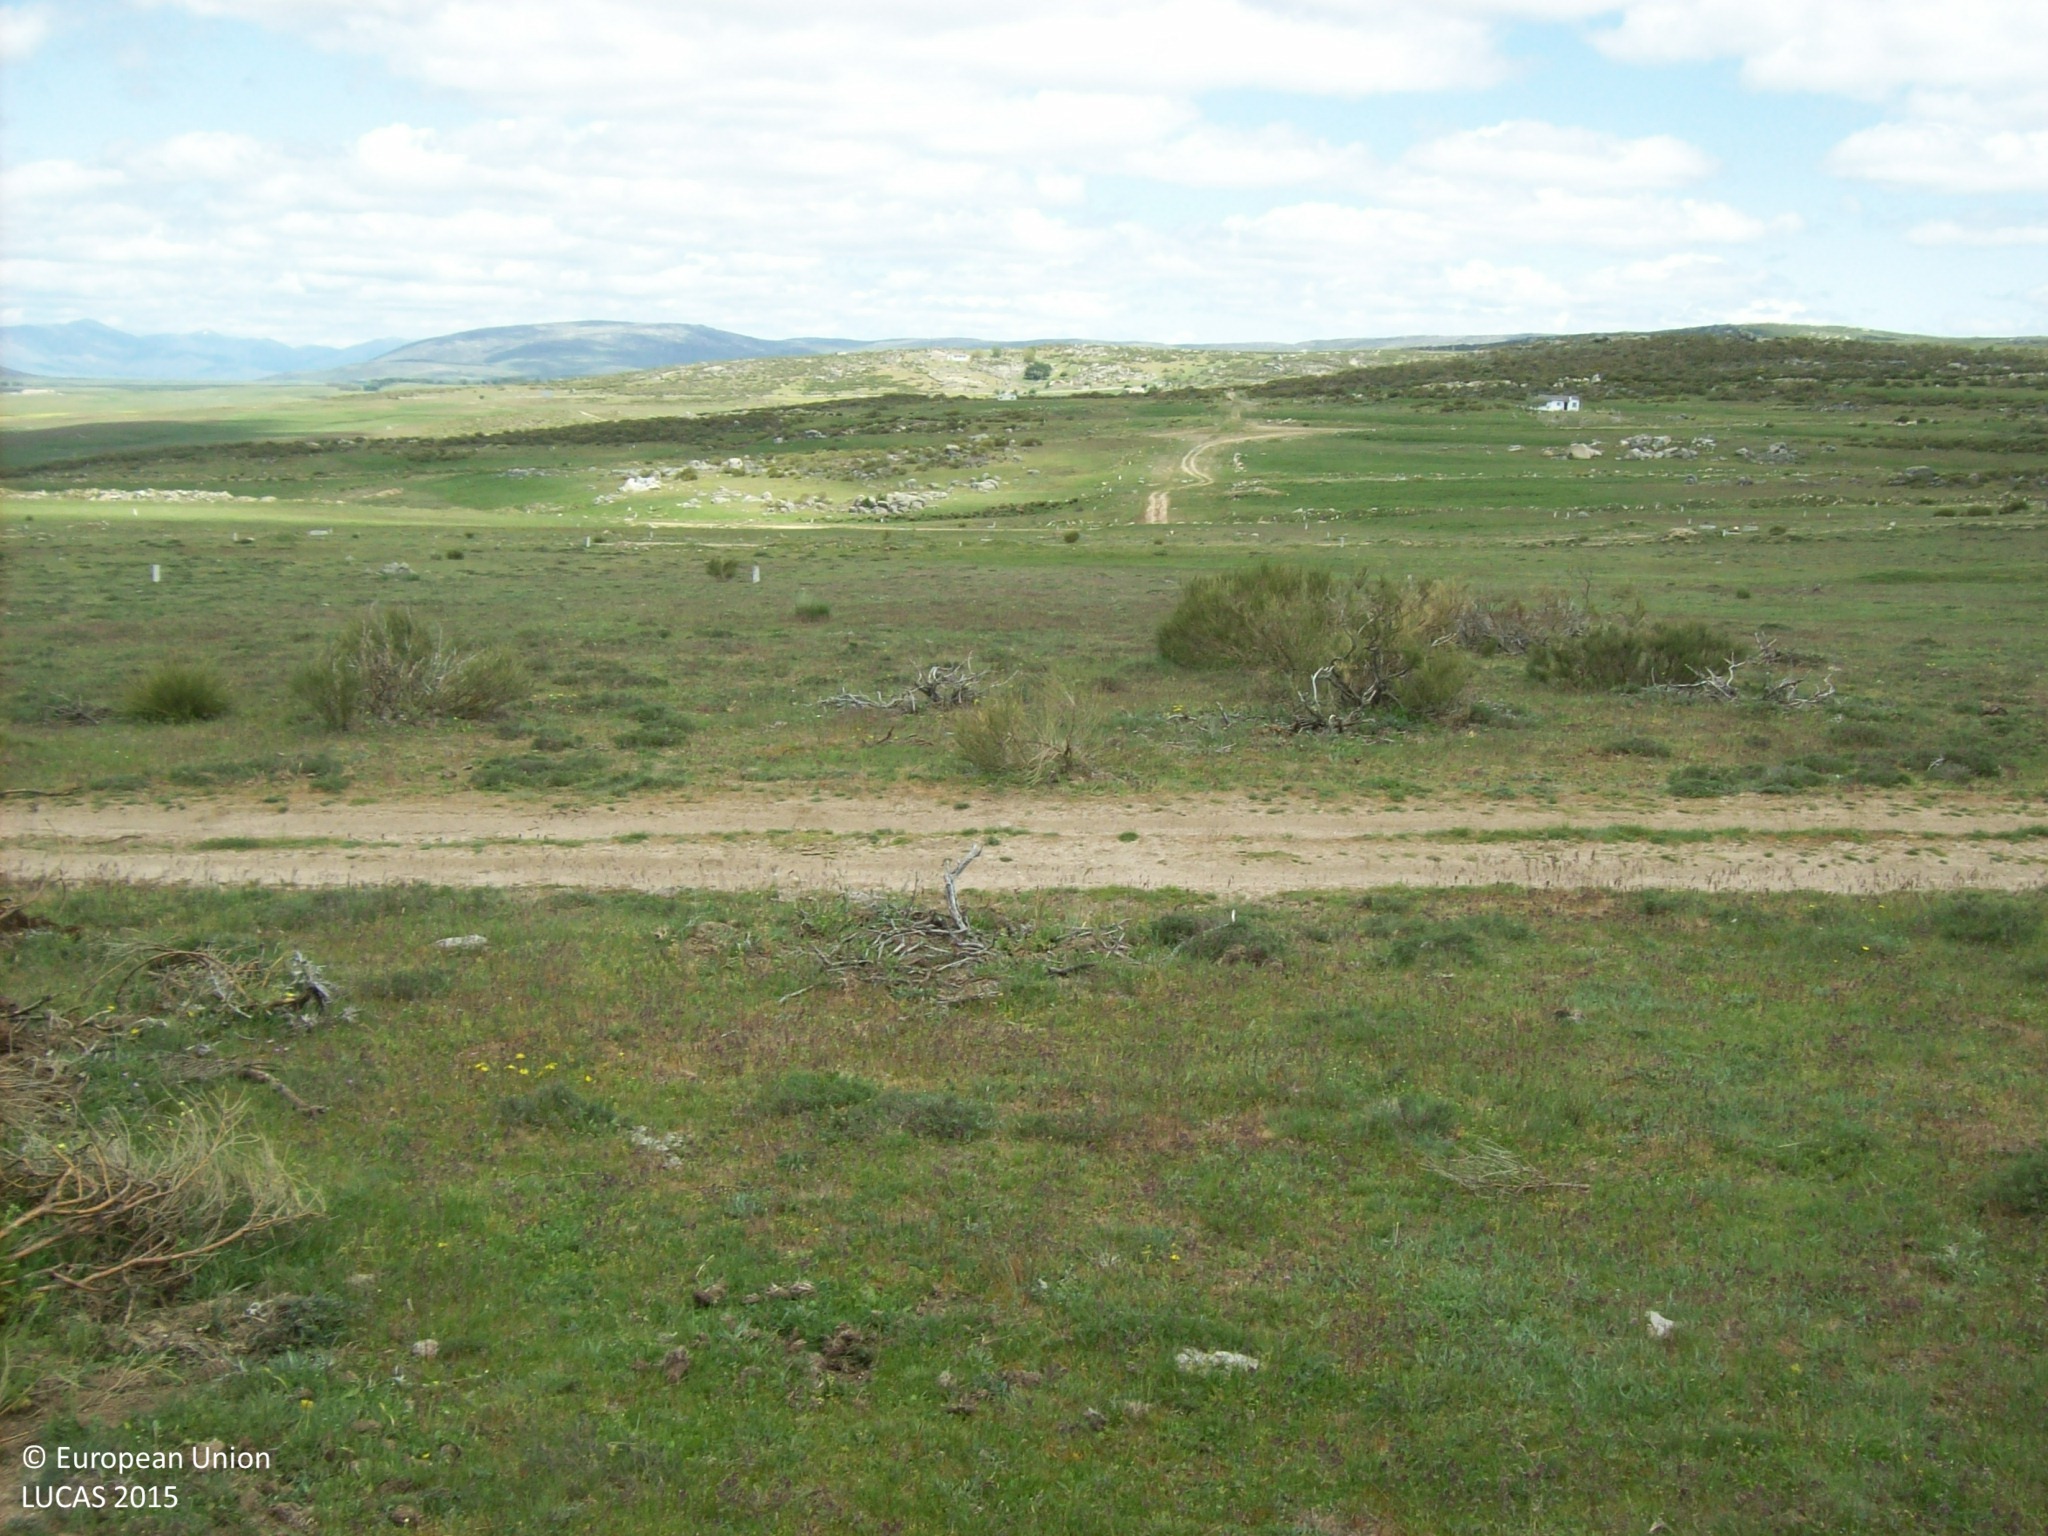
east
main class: Grassland
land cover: Grassland without tree/shrub cover
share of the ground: > 75 %
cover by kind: herbaceous plants 95 %, shrubs 5 %
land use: Agriculture (excluding fallow land and kitchen gardens)
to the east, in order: Grassland without tree/shrub cover; Shrubland without tree cover; Fences; Shrubland without tree cover; Tracks; Shrubland without tree cover; Grassland without tree/shrub cover; Tracks; Grassland without tree/shrub cover
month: May
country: ES
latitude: 40.6593
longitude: -4.4459
